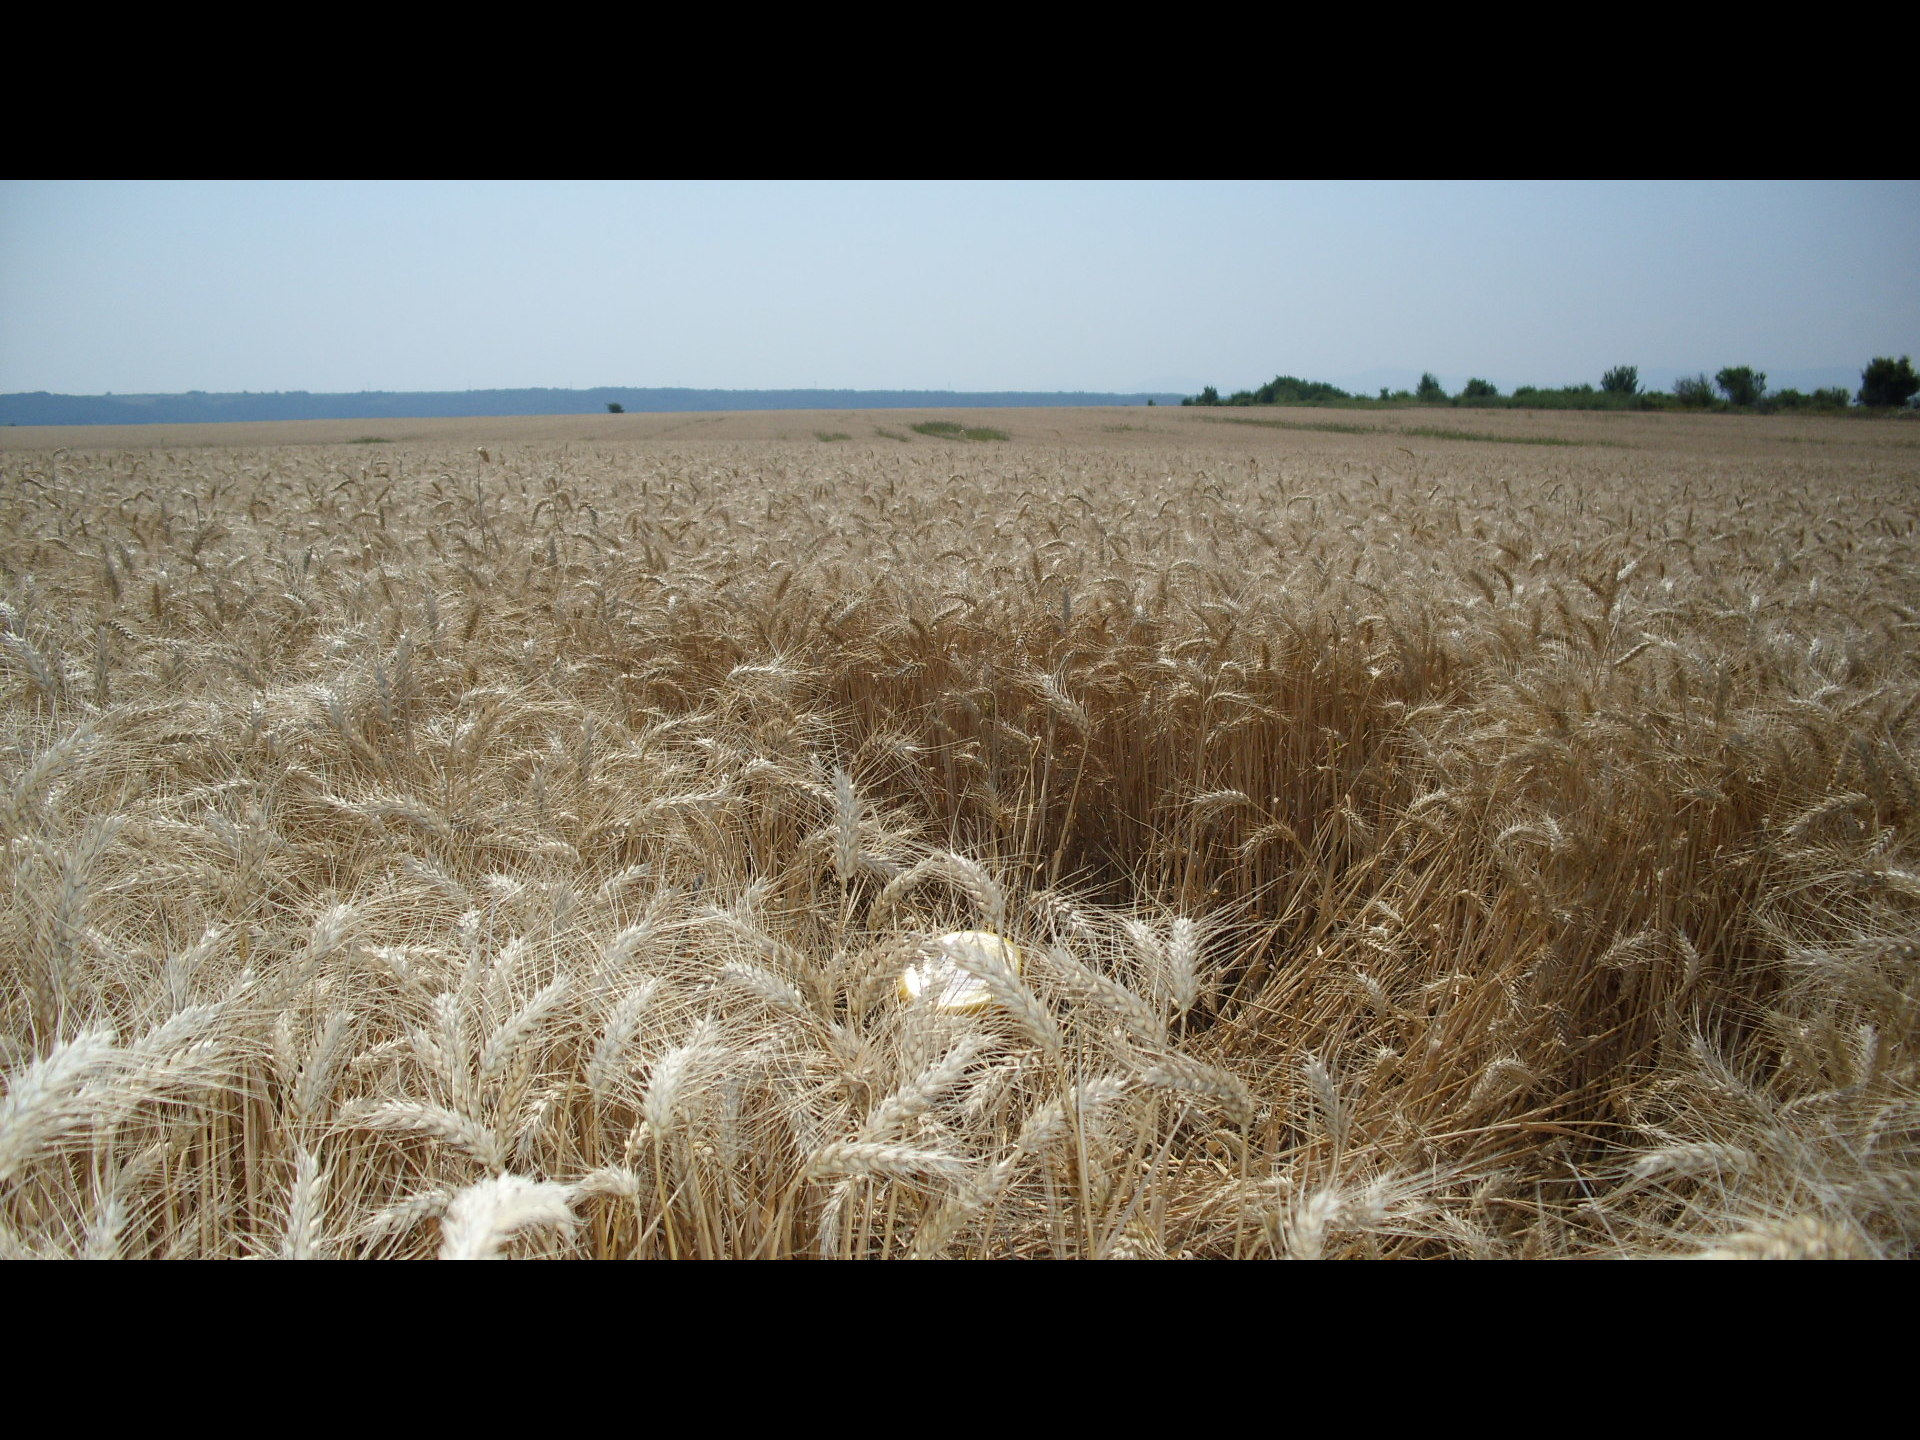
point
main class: Cropland
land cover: Common wheat
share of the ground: > 75 %
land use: Agriculture (excluding fallow land and kitchen gardens)
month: July
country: BG
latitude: 43.6873
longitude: 22.9023
